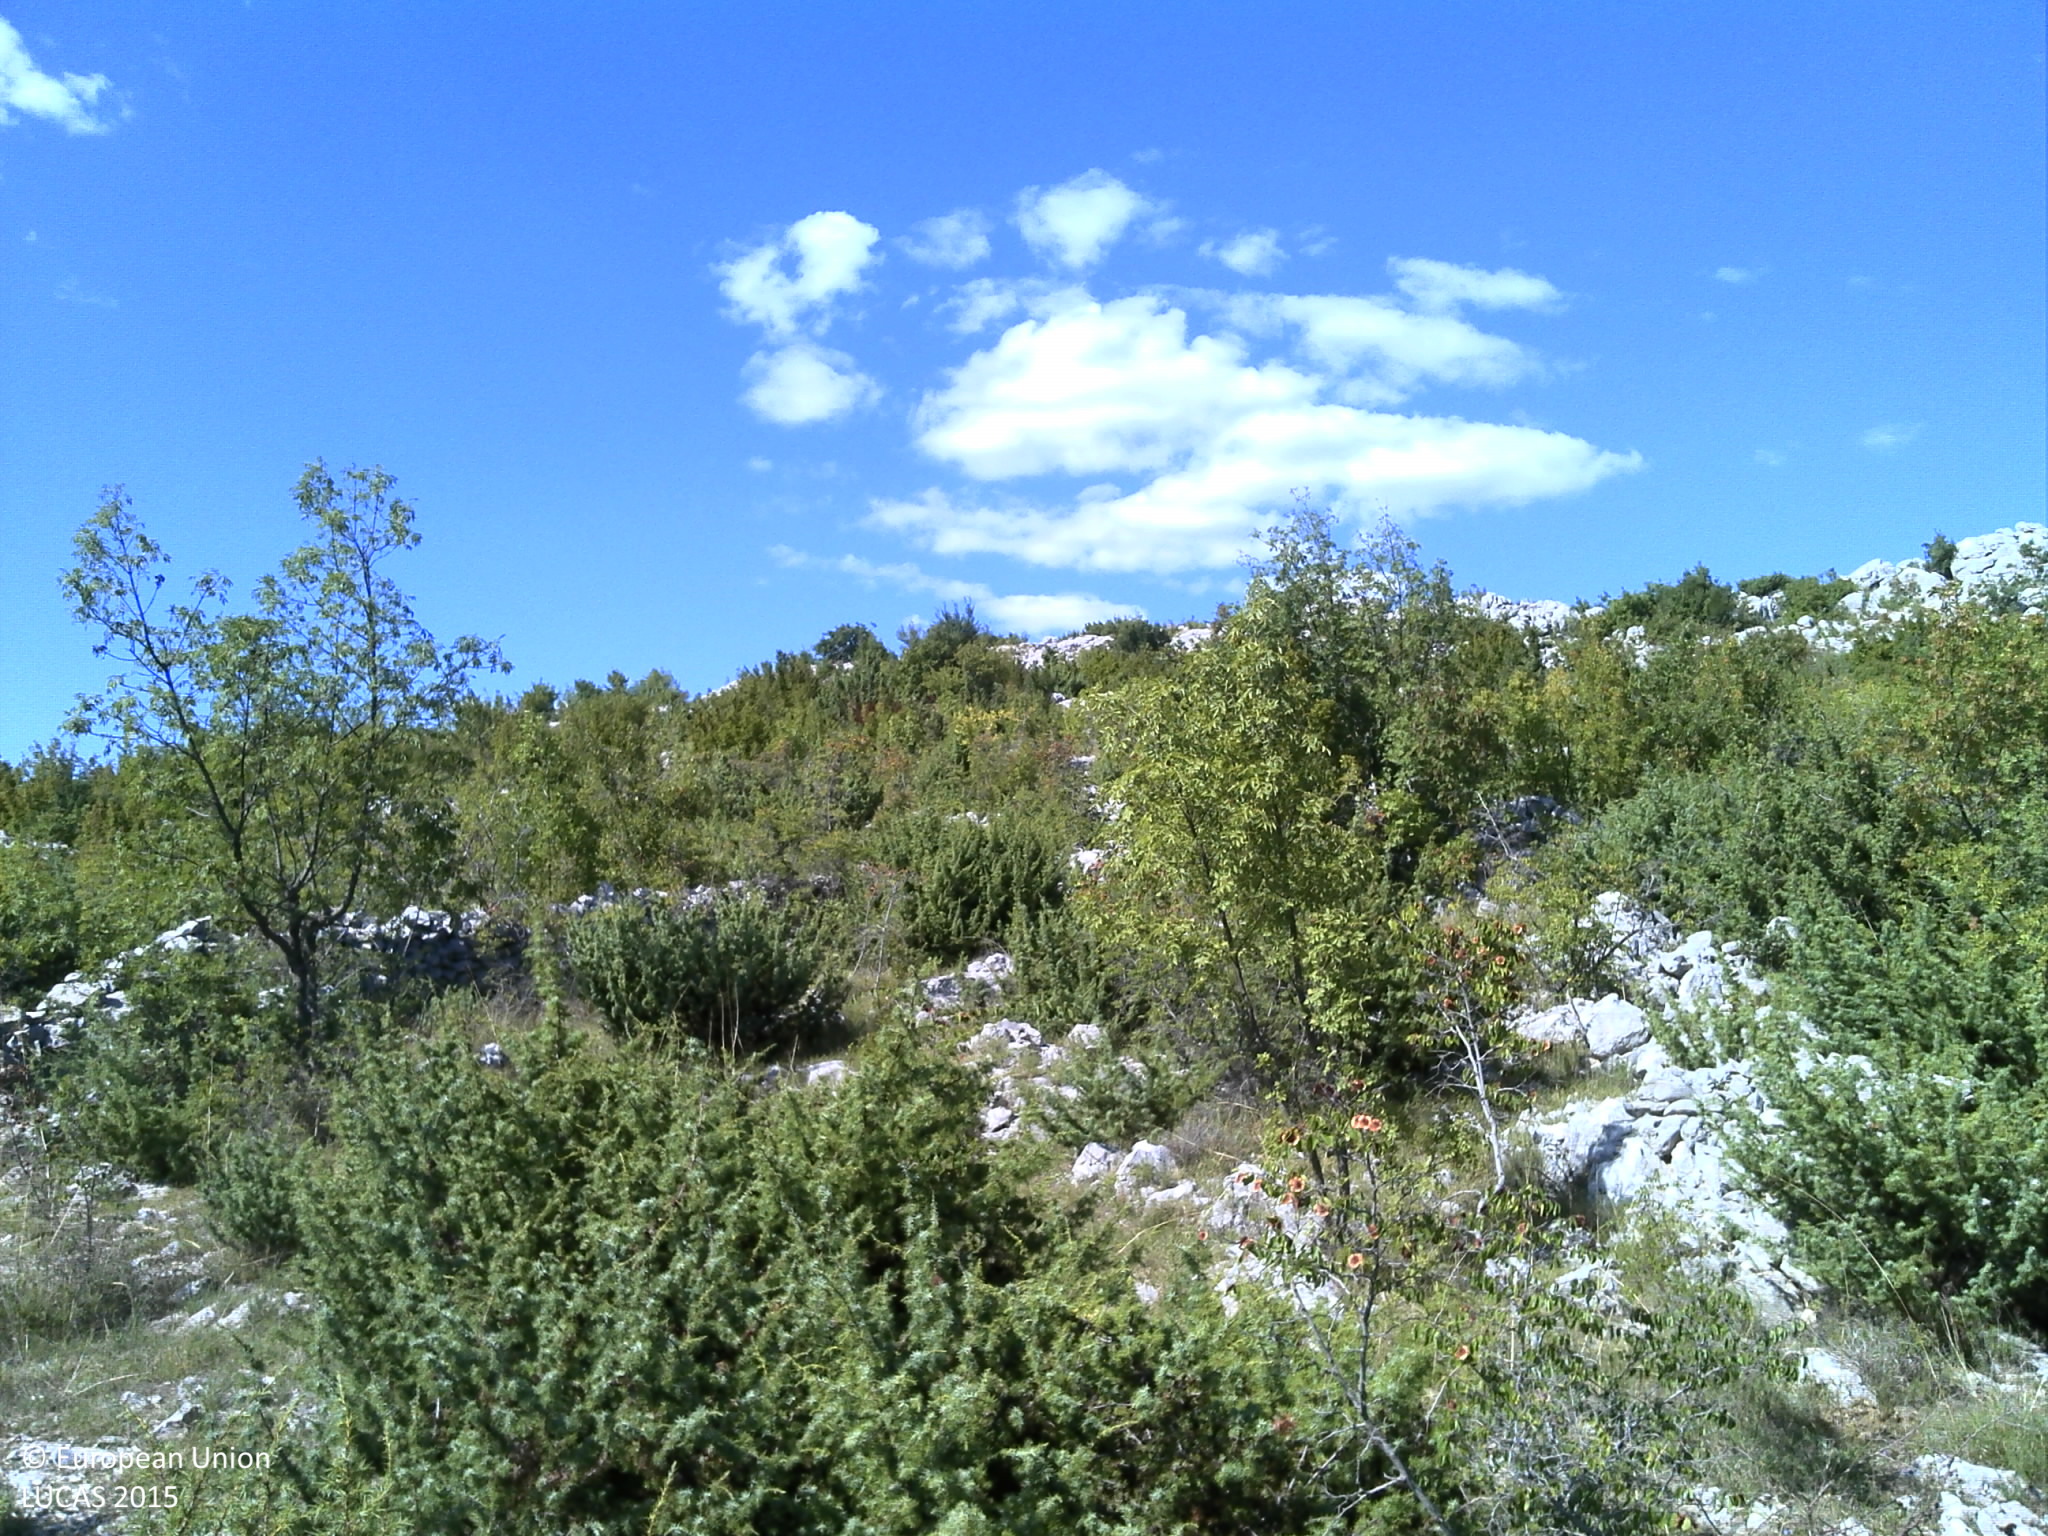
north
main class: Shrubland
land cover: Shrubland without tree cover
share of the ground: 25 - 50 %
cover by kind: consolidated bare surface 35 %, herbaceous plants 30 %, shrubs 25 %, unconsolidated bare surface 10 %
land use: Abandoned areas
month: September
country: HR
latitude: 43.6345
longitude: 16.3002
